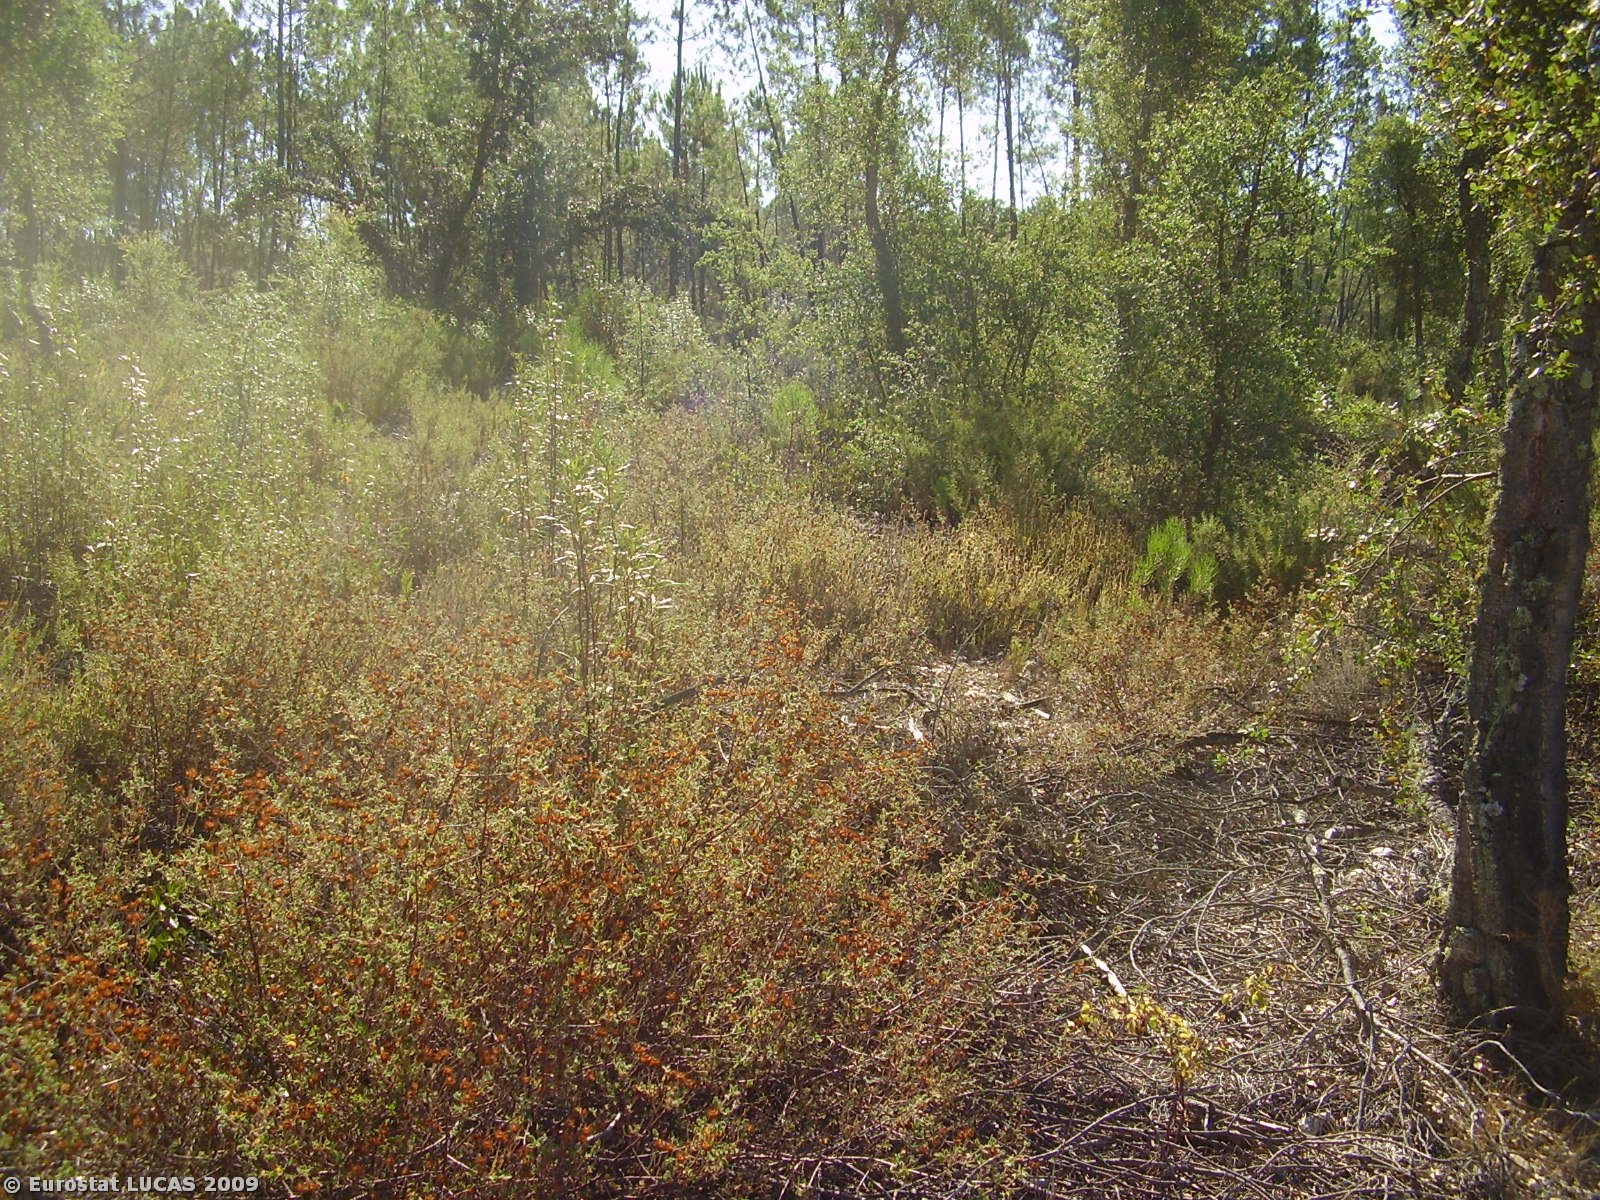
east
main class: Woodland
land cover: Broadleaved woodland
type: broadleaved evergreen forest
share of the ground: 10 - 25 %
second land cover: Shrubland with sparse tree cover
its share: 50 - 75 %
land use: Forestry
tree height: > 5 m
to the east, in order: Broadleaved woodland; Shrubland with sparse tree cover; Broadleaved woodland; Mixed woodland; Tracks; Rivers and streams; Coniferous woodland; Broadleaved woodland; Tracks; Electric lines; Spontaneously vegetated surfaces; Broadleaved woodland
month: July
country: PT
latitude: 39.3483
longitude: -8.0791
